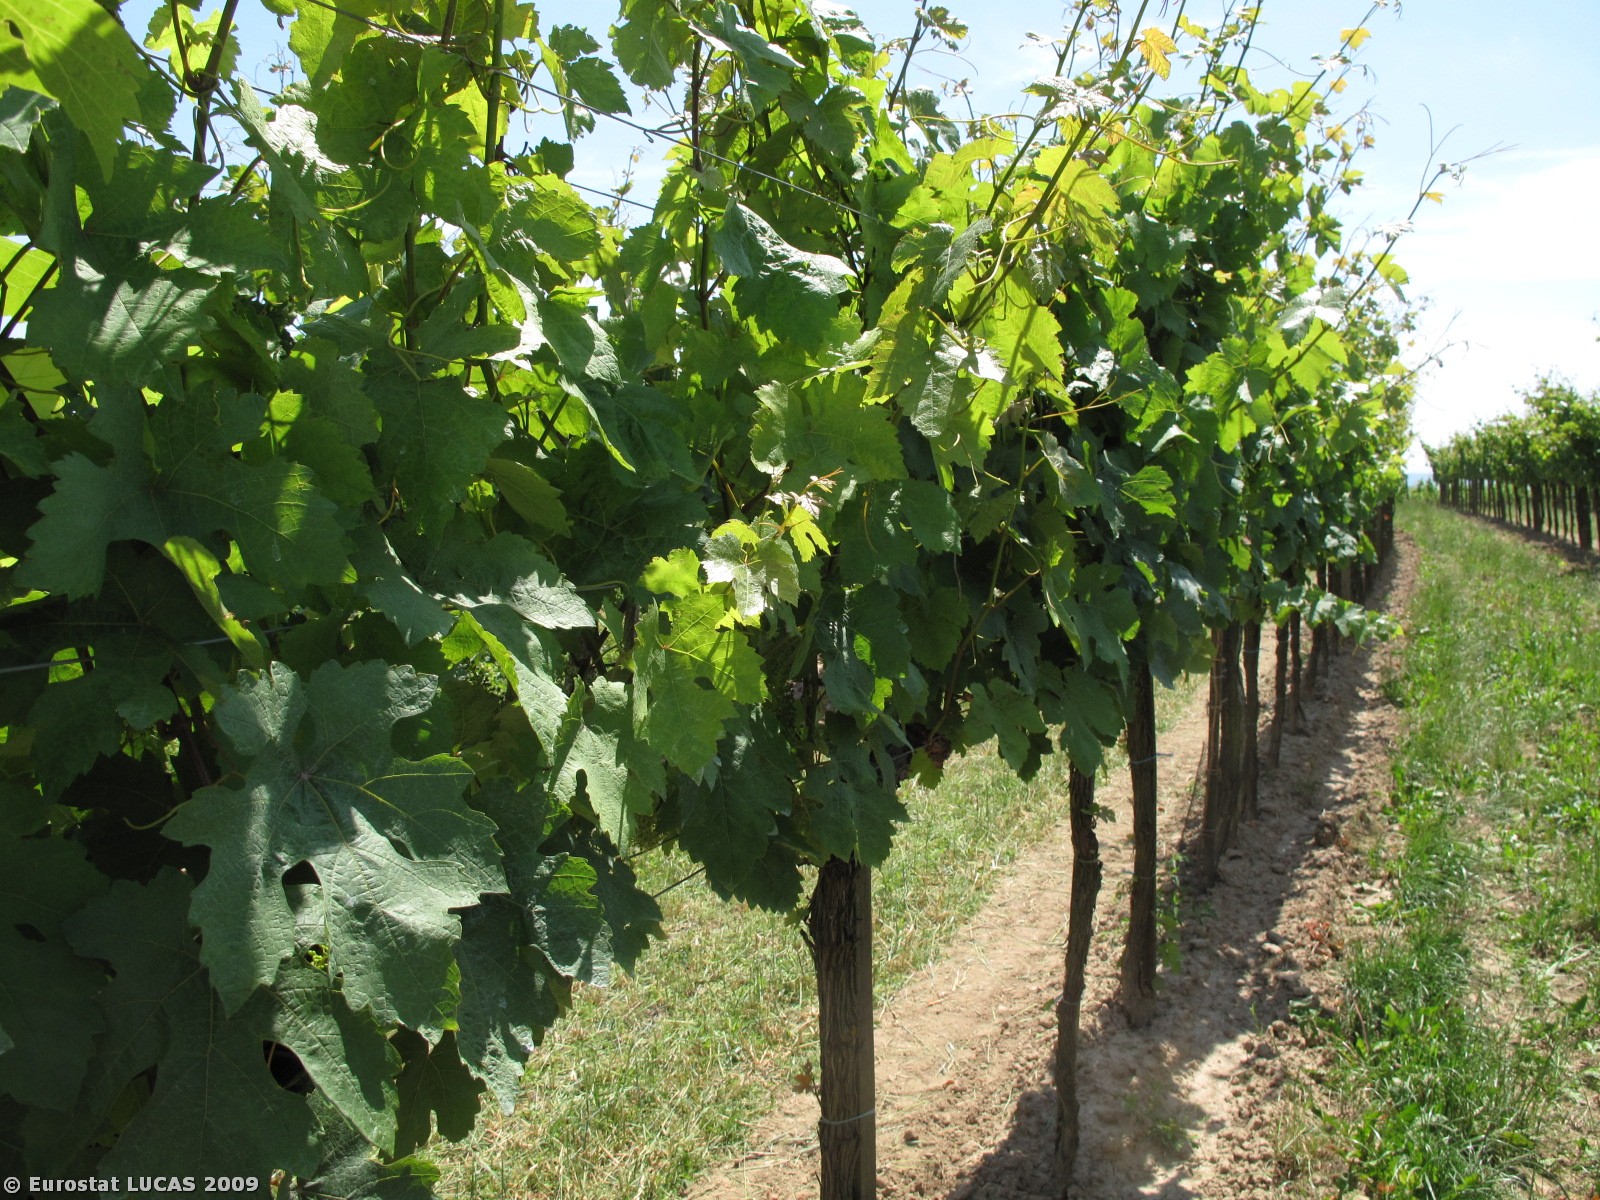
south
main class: Cropland
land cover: Vineyards
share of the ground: < 10 %
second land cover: Grassland with sparse tree/shrub cover
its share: 25 - 50 %
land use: Agriculture (excluding fallow land and kitchen gardens)
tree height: < 5 m
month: June
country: AT
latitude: 48.4811
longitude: 15.8888
